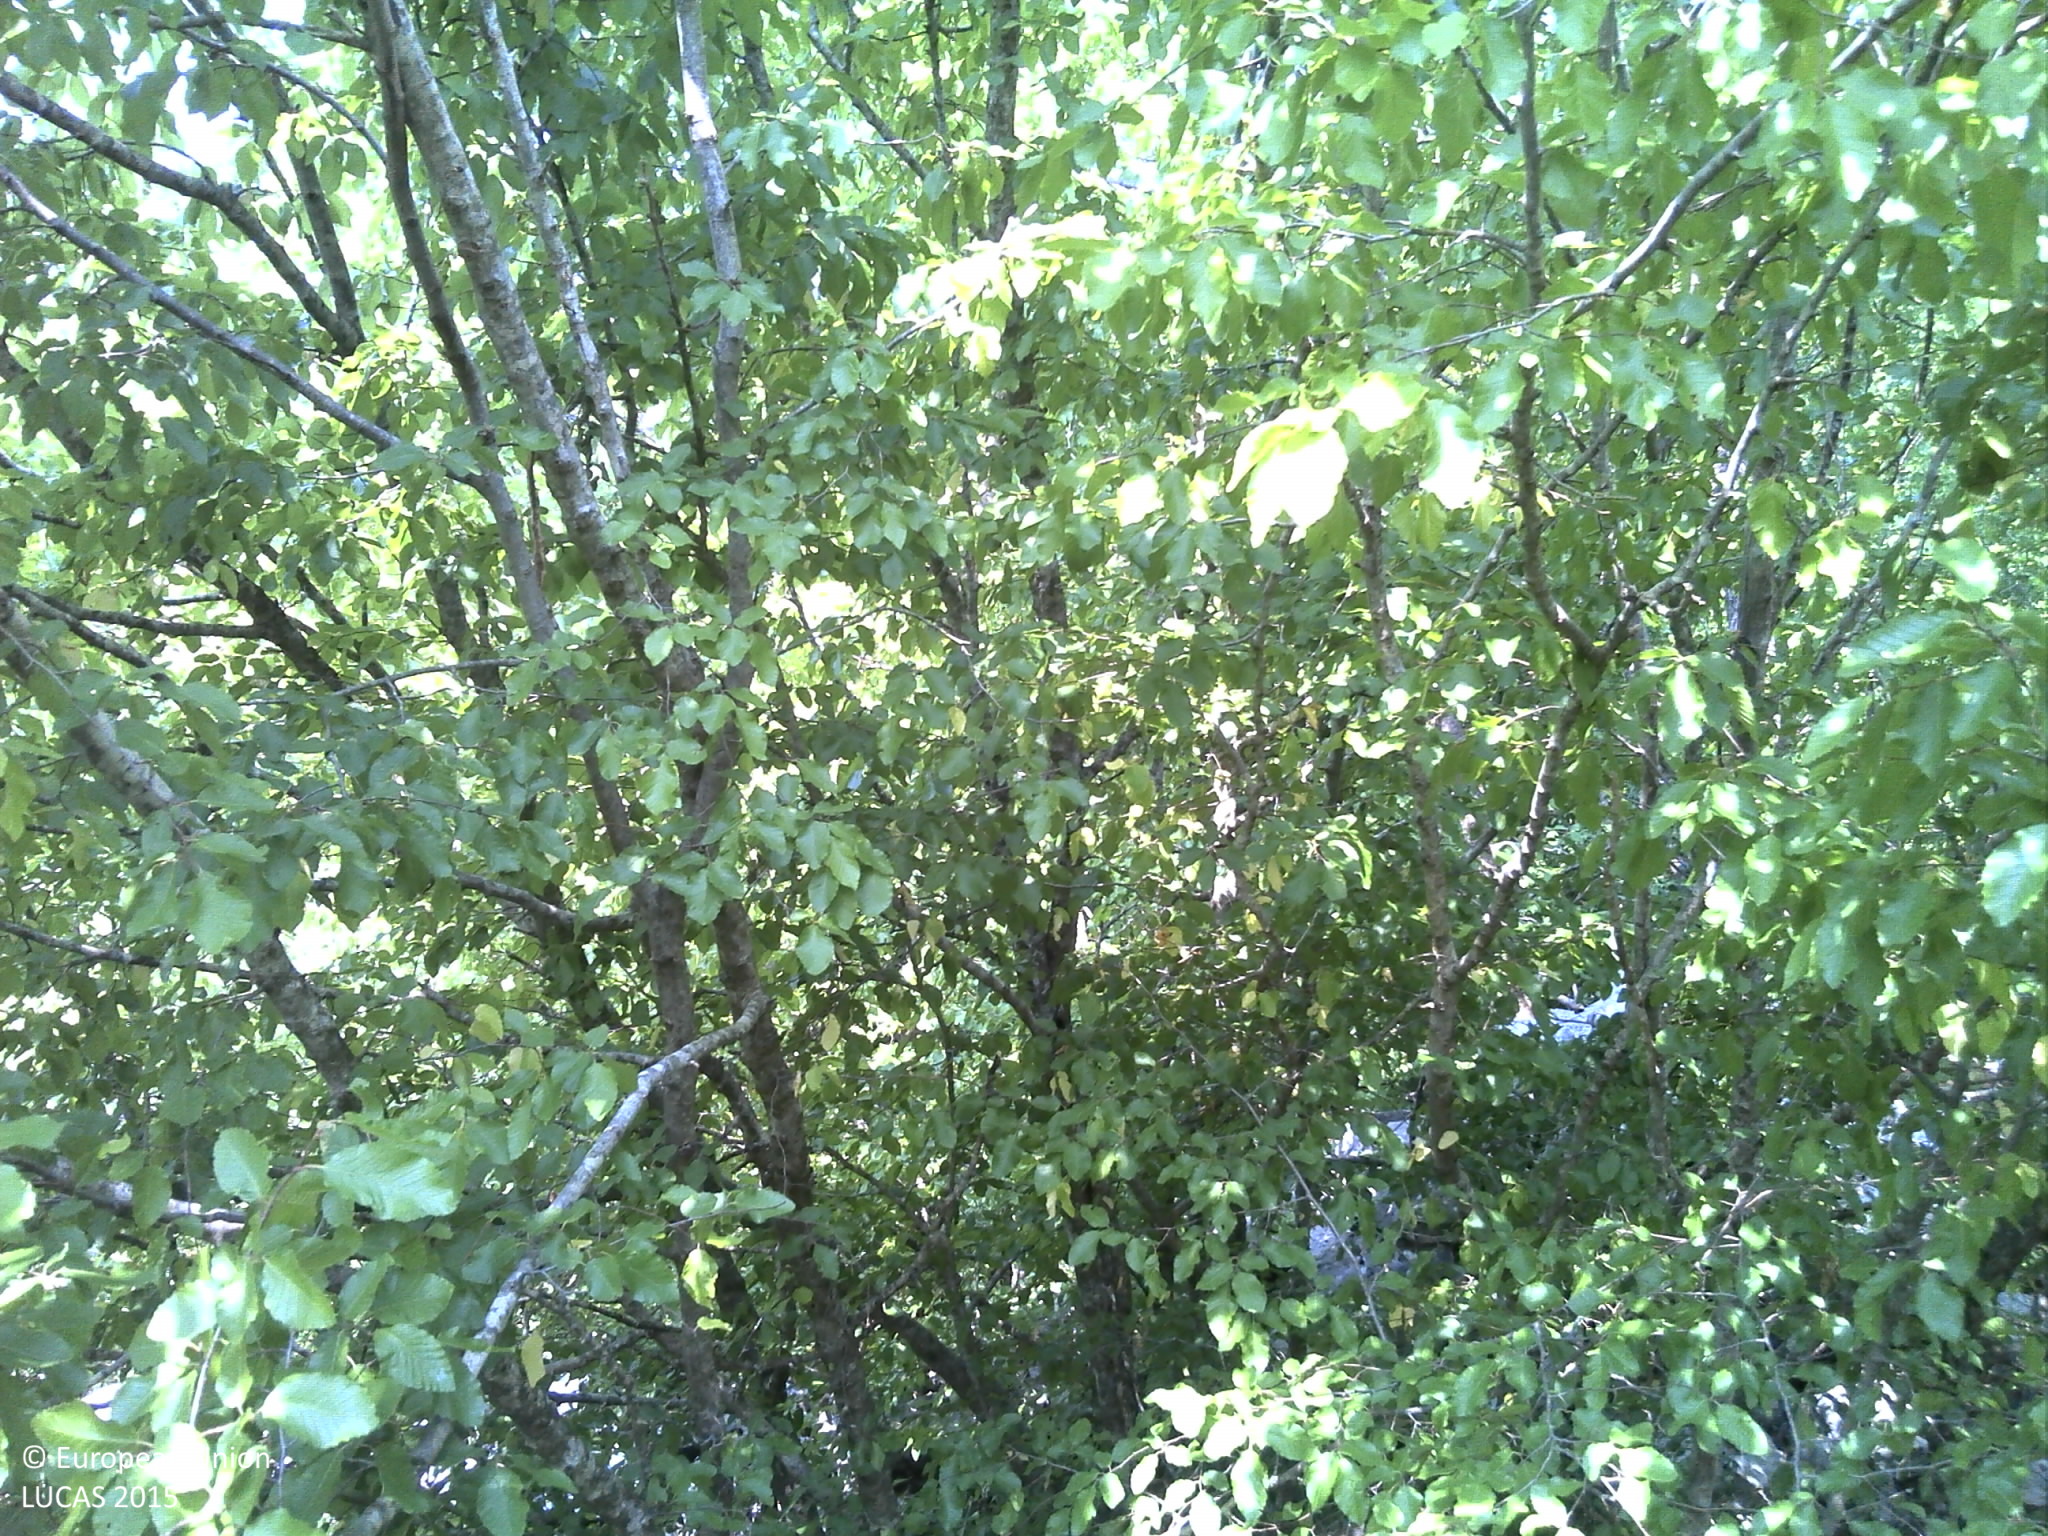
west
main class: Woodland
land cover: Broadleaved woodland
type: thermophilous deciduous forest
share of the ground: 50 - 75 %
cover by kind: broadleaved forest trees 65 %, shrubs 25 %, herbaceous plants 5 %, consolidated bare surface 5 %
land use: Semi-natural and natural areas not in use
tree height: > 5 m
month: July
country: HR
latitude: 43.5033
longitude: 16.9301
